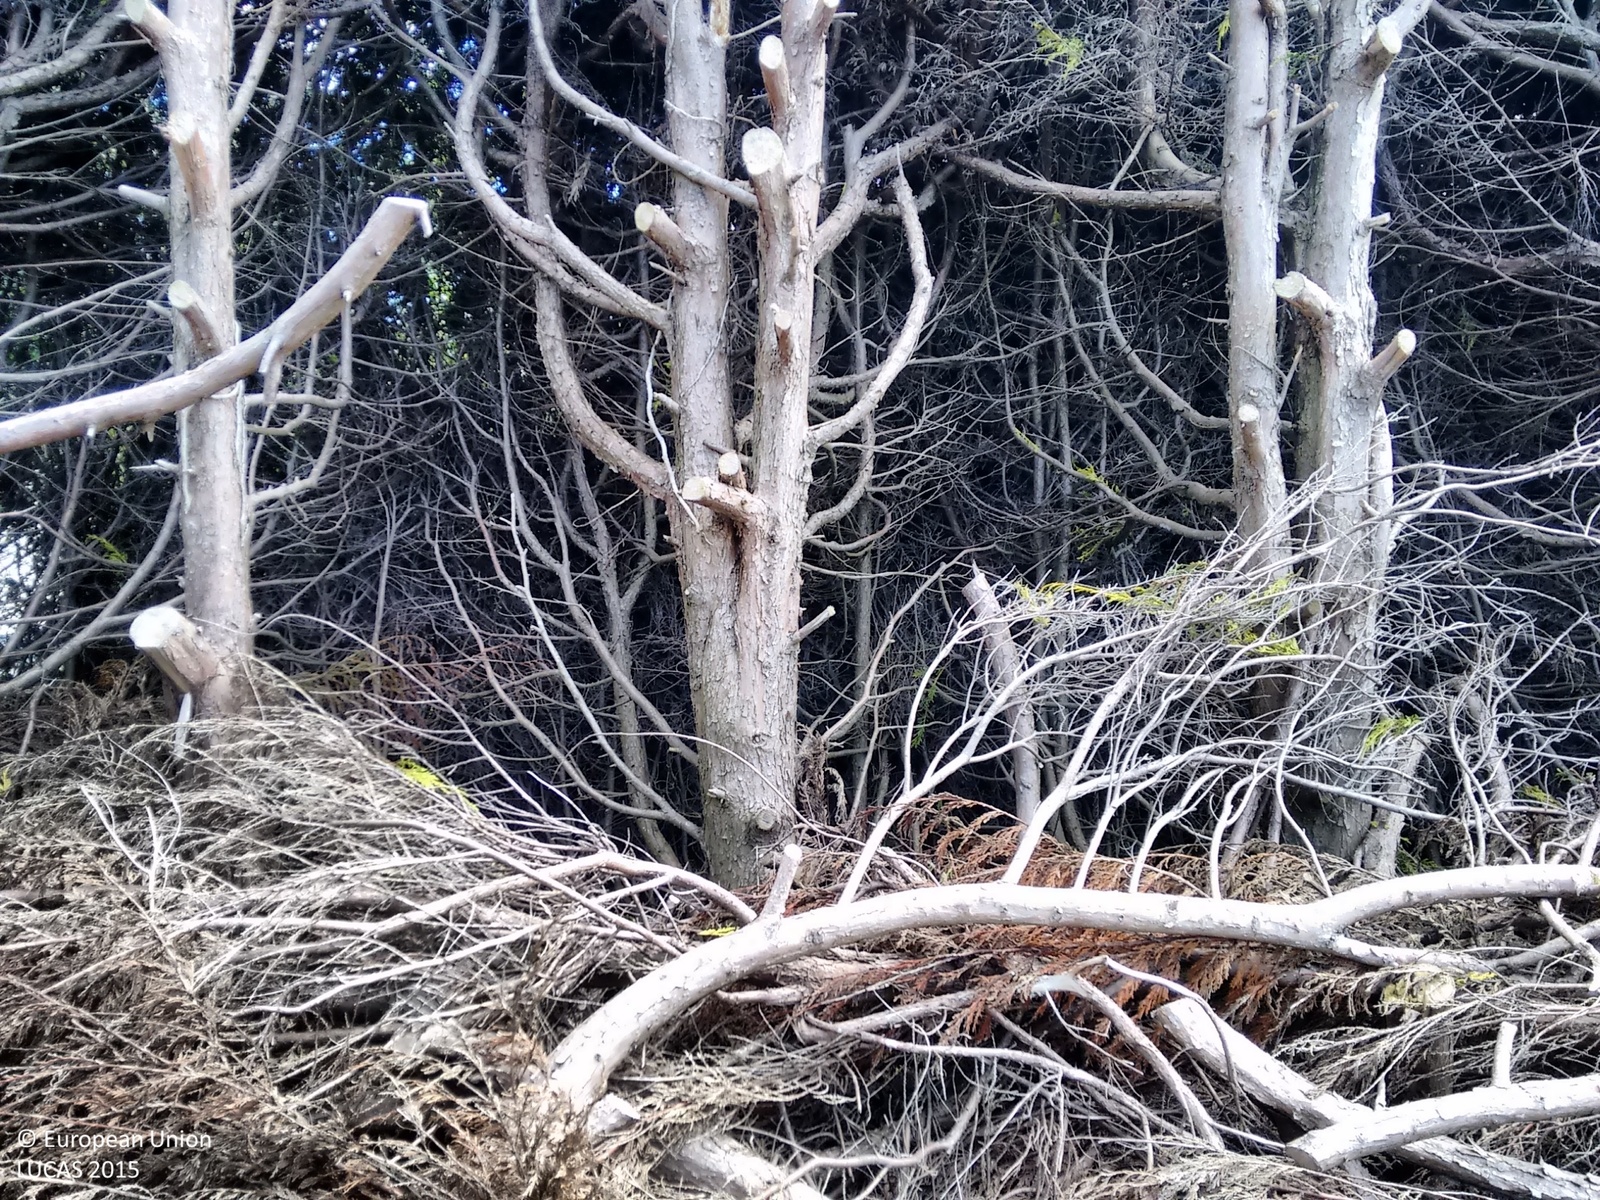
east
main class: Grassland
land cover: Grassland with sparse tree/shrub cover
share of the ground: > 75 %
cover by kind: herbaceous plants 95 %, broadleaved forest trees 5 %
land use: Residential
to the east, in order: Grassland with sparse tree/shrub cover; Artificial constructions in urban areas; Abandoned hedges; Fences; Grassland without tree/shrub cover; Abandoned hedges; Grassland without tree/shrub cover; Fences; Abandoned hedges; Grass margins; Electric lines; Paved roads, cycling and walking lanes; Ditches and canals; Abandoned hedges; Artificial constructions in urban areas
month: August
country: IE
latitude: 52.2903
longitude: -6.5346
